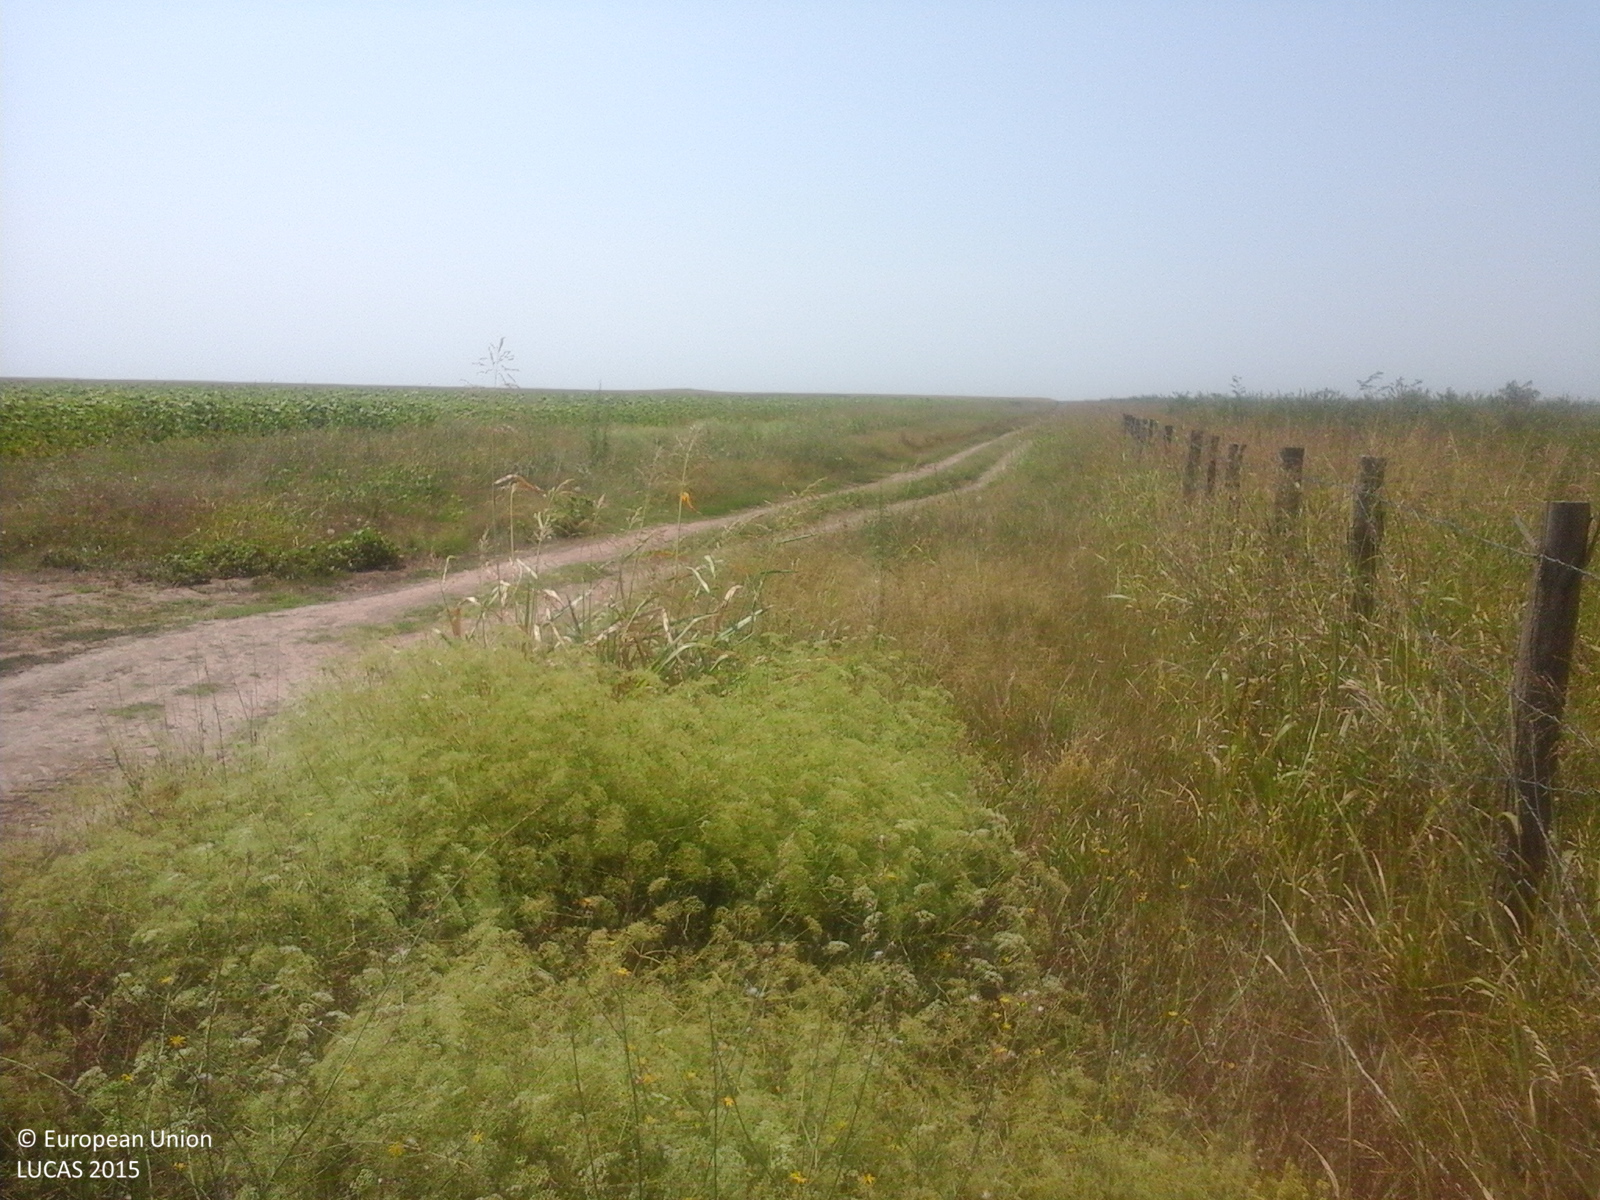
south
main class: Woodland
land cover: Broadleaved woodland
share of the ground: 10 - 25 %
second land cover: Spontaneously vegetated surfaces
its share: > 75 %
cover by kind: herbaceous plants 80 %, broadleaved forest trees 20 %
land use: Forestry
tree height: < 5 m
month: August
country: RO
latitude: 45.1334
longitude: 27.7162
